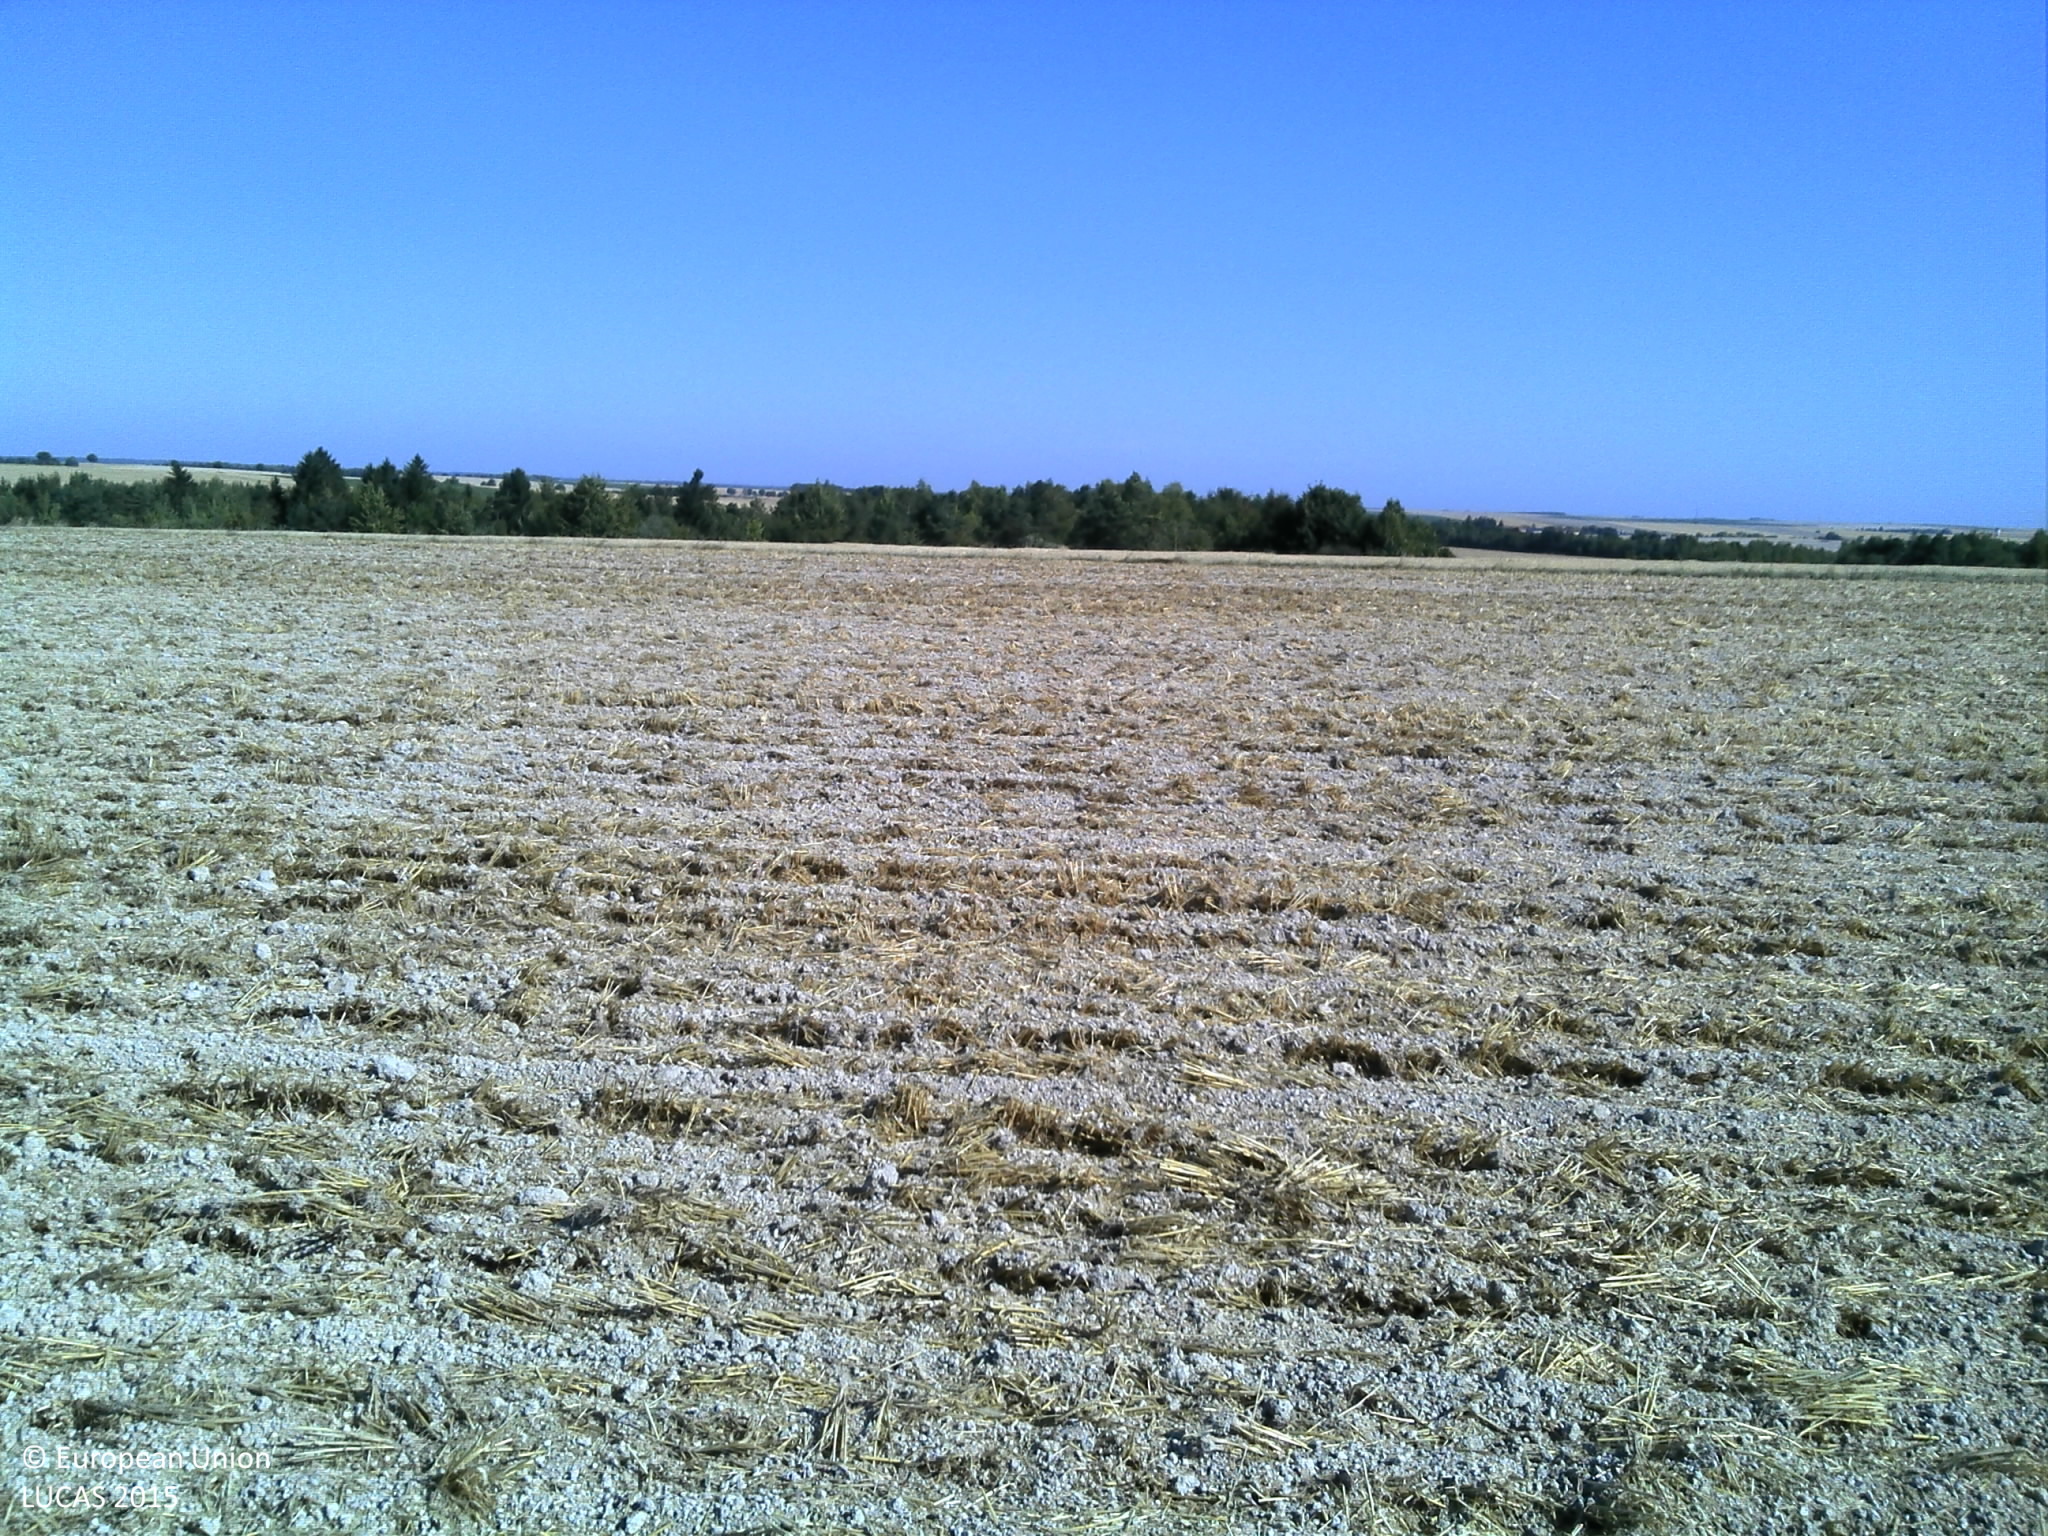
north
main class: Cropland
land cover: Common wheat
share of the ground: > 75 %
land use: Agriculture (excluding fallow land and kitchen gardens)
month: August
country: FR
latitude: 49.0710
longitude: 4.7272
